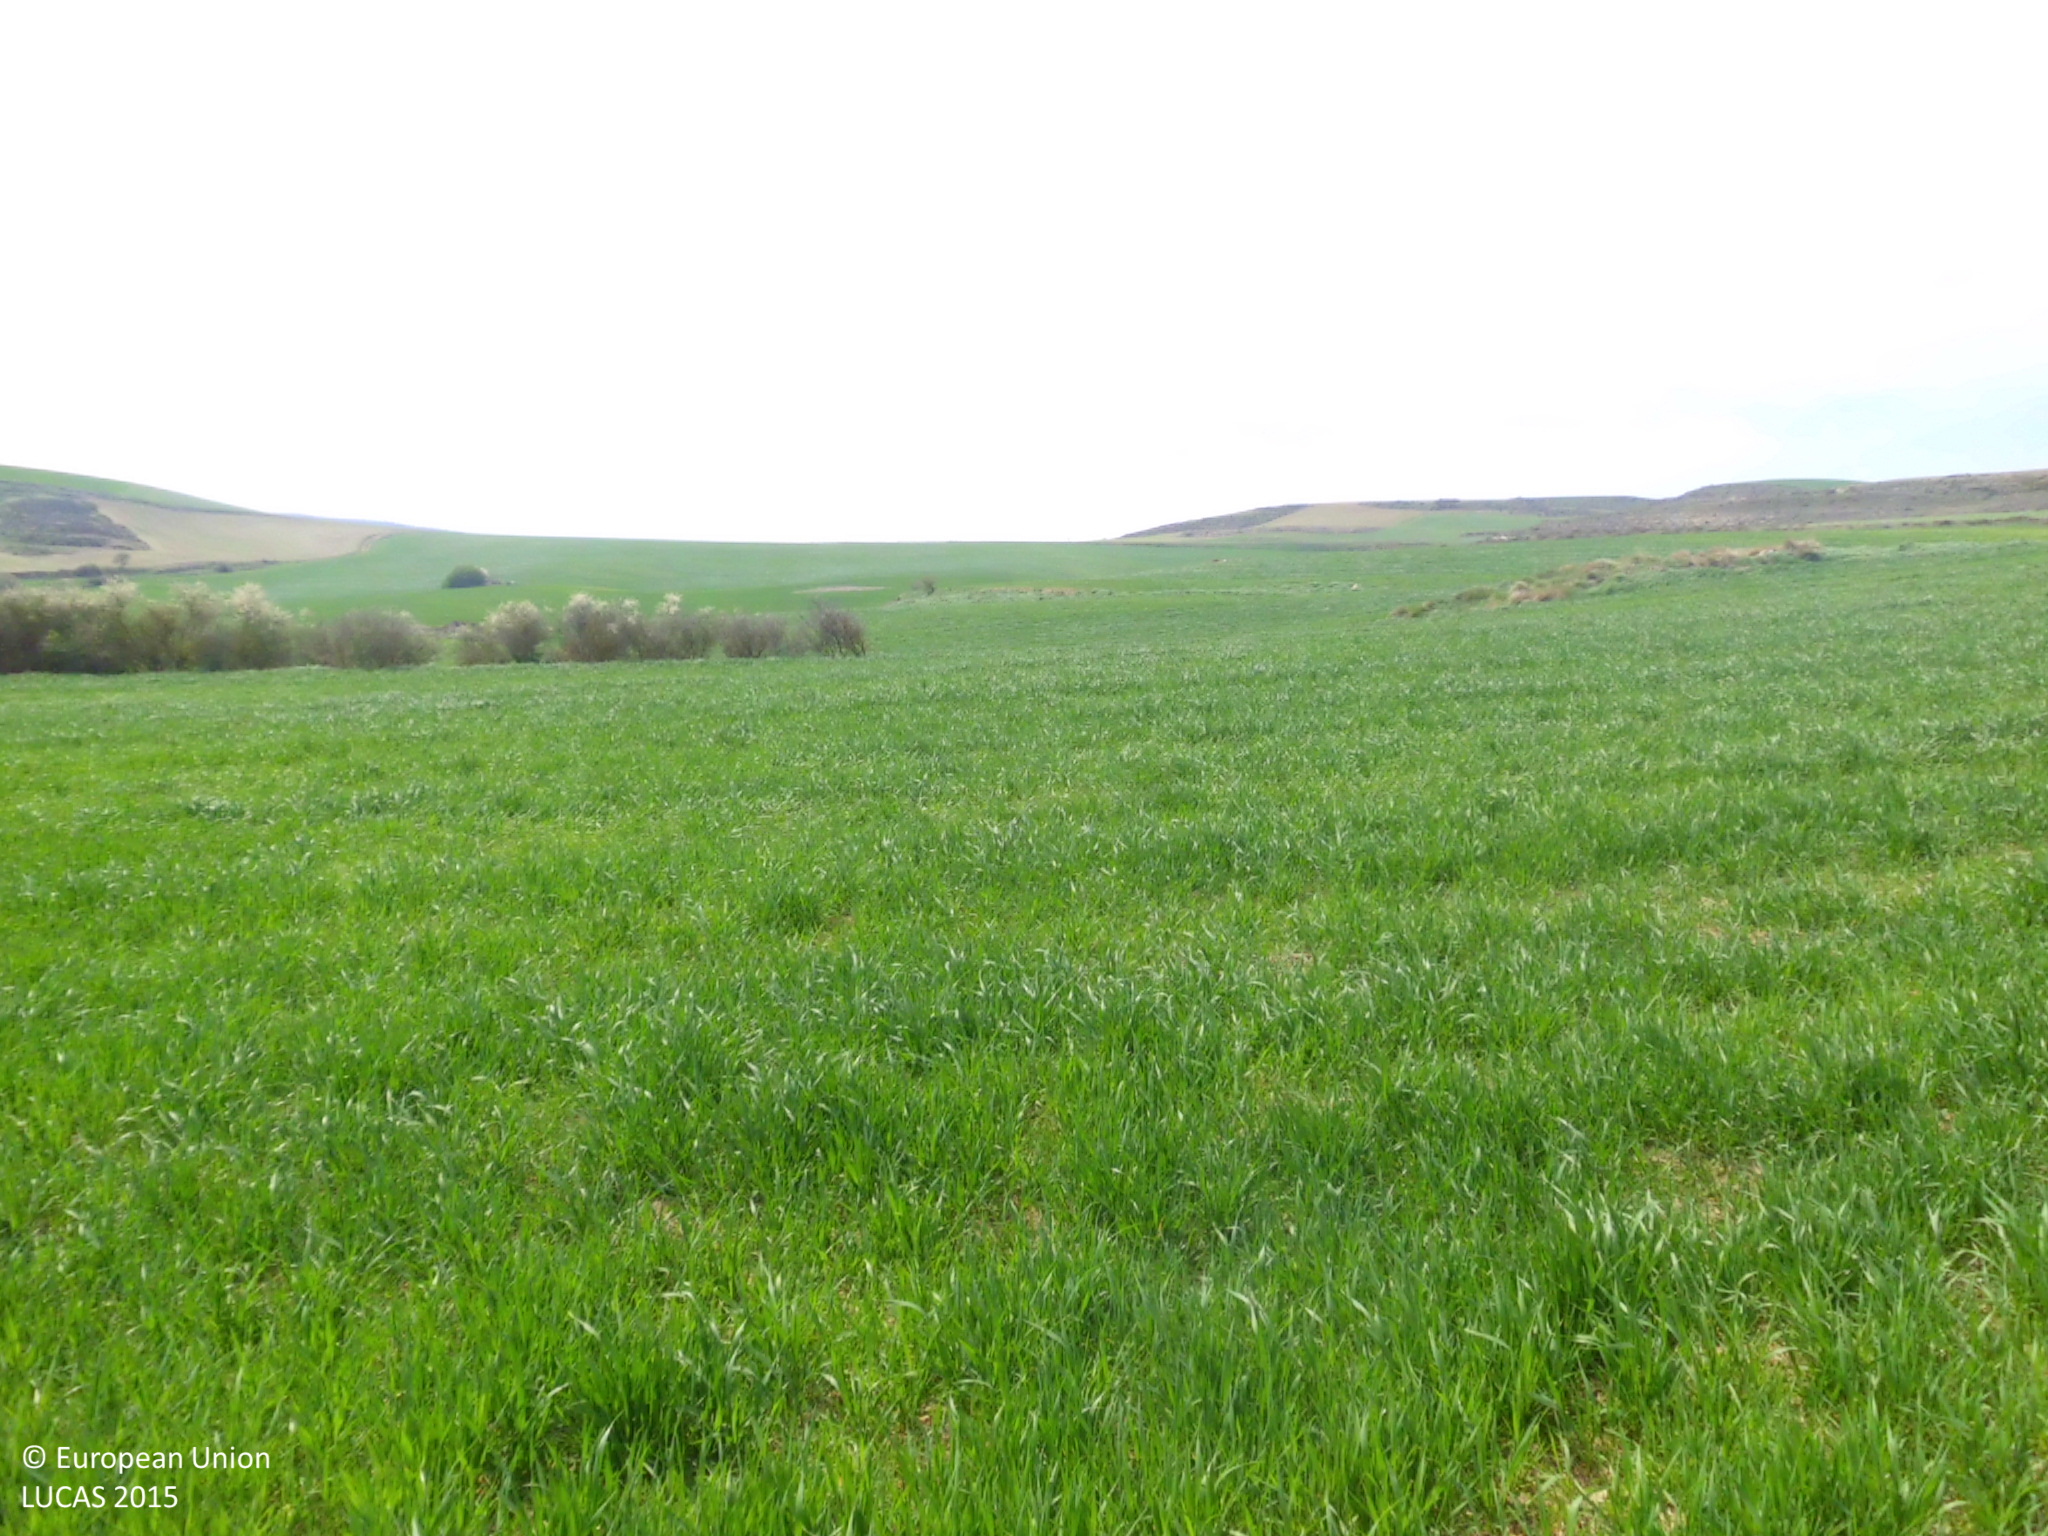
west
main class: Cropland
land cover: Barley
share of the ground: > 75 %
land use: Agriculture (excluding fallow land and kitchen gardens)
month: April
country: ES
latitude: 42.4138
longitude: -3.2886
